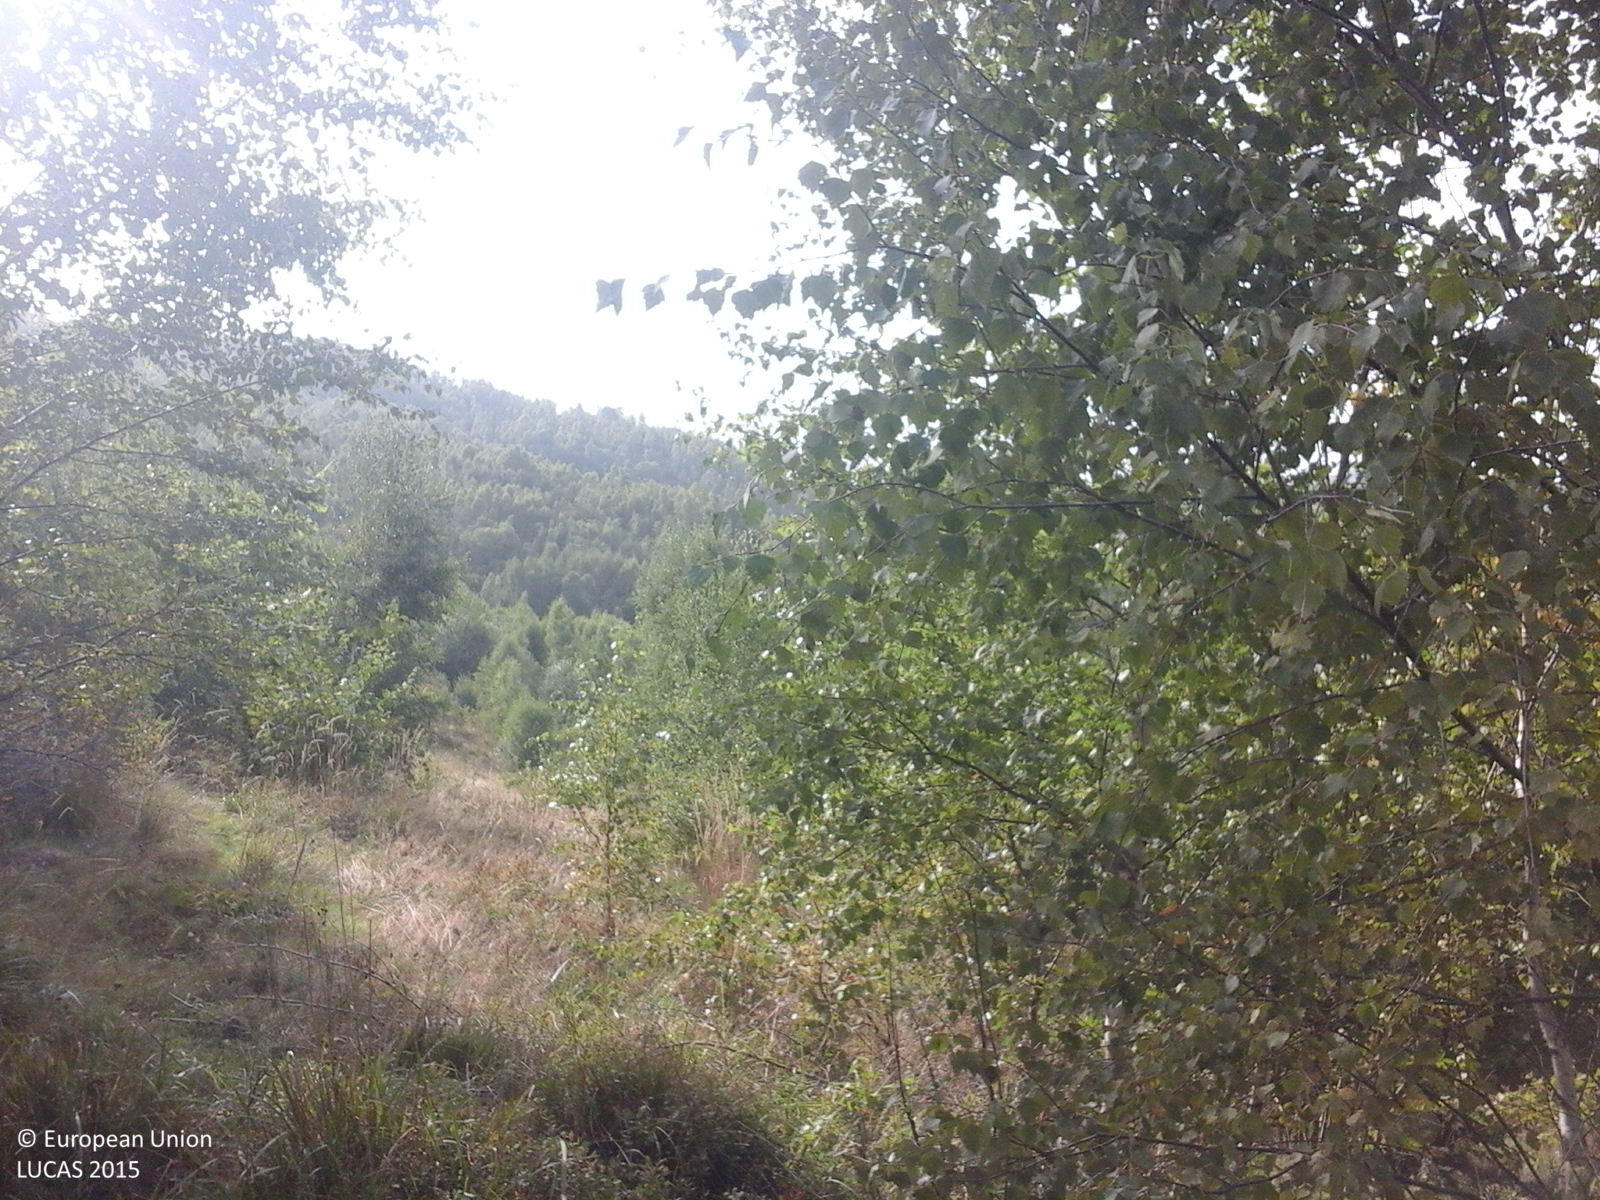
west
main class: Woodland
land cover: Broadleaved woodland
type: acidophilous oak and oak-birch forest
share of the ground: > 75 %
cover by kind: broadleaved forest trees 100 %
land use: Forestry
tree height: > 5 m
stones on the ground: < 10 %
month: September
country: RO
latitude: 46.6794
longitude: 23.3353
